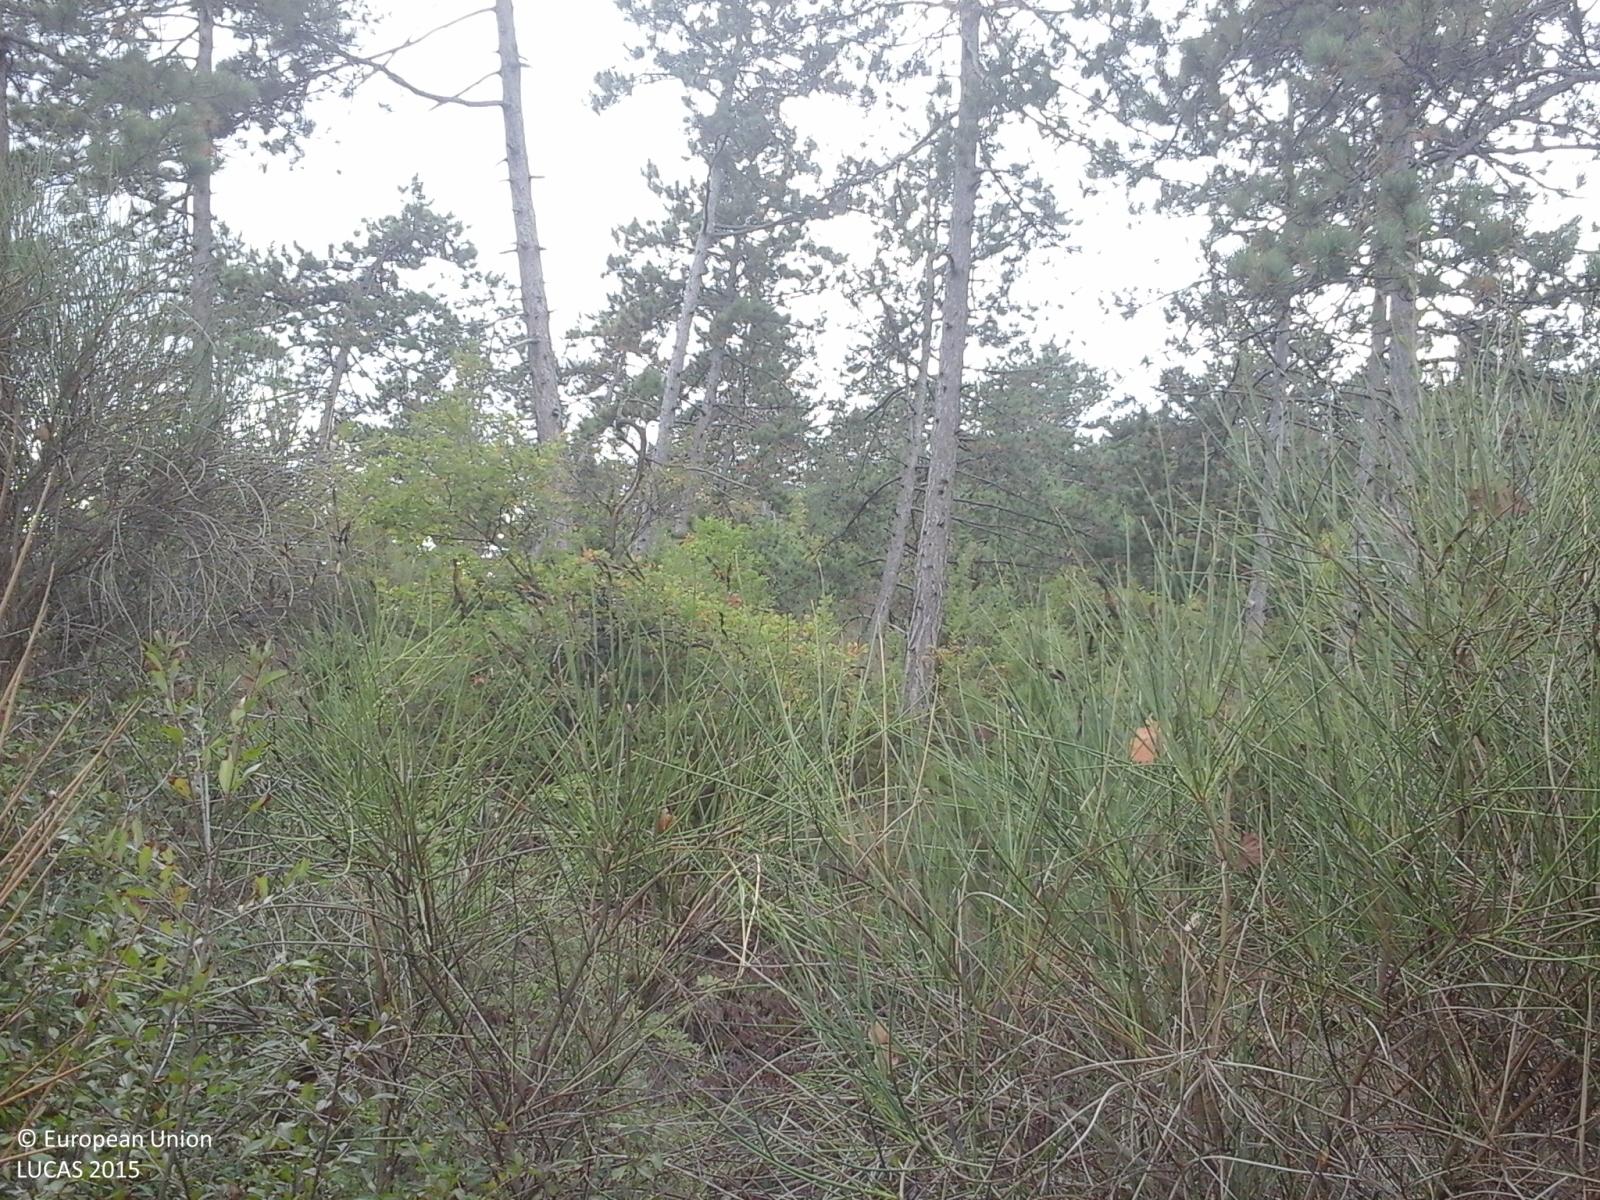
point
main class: Woodland
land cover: Pine dominated mixed woodland
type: coniferous forest of the mediterranean region
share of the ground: > 75 %
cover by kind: coniferous forest trees 50 %, broadleaved forest trees 35 %, shrubs 15 %
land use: Forestry
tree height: > 5 m
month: October
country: IT
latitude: 43.2957
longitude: 12.3231
